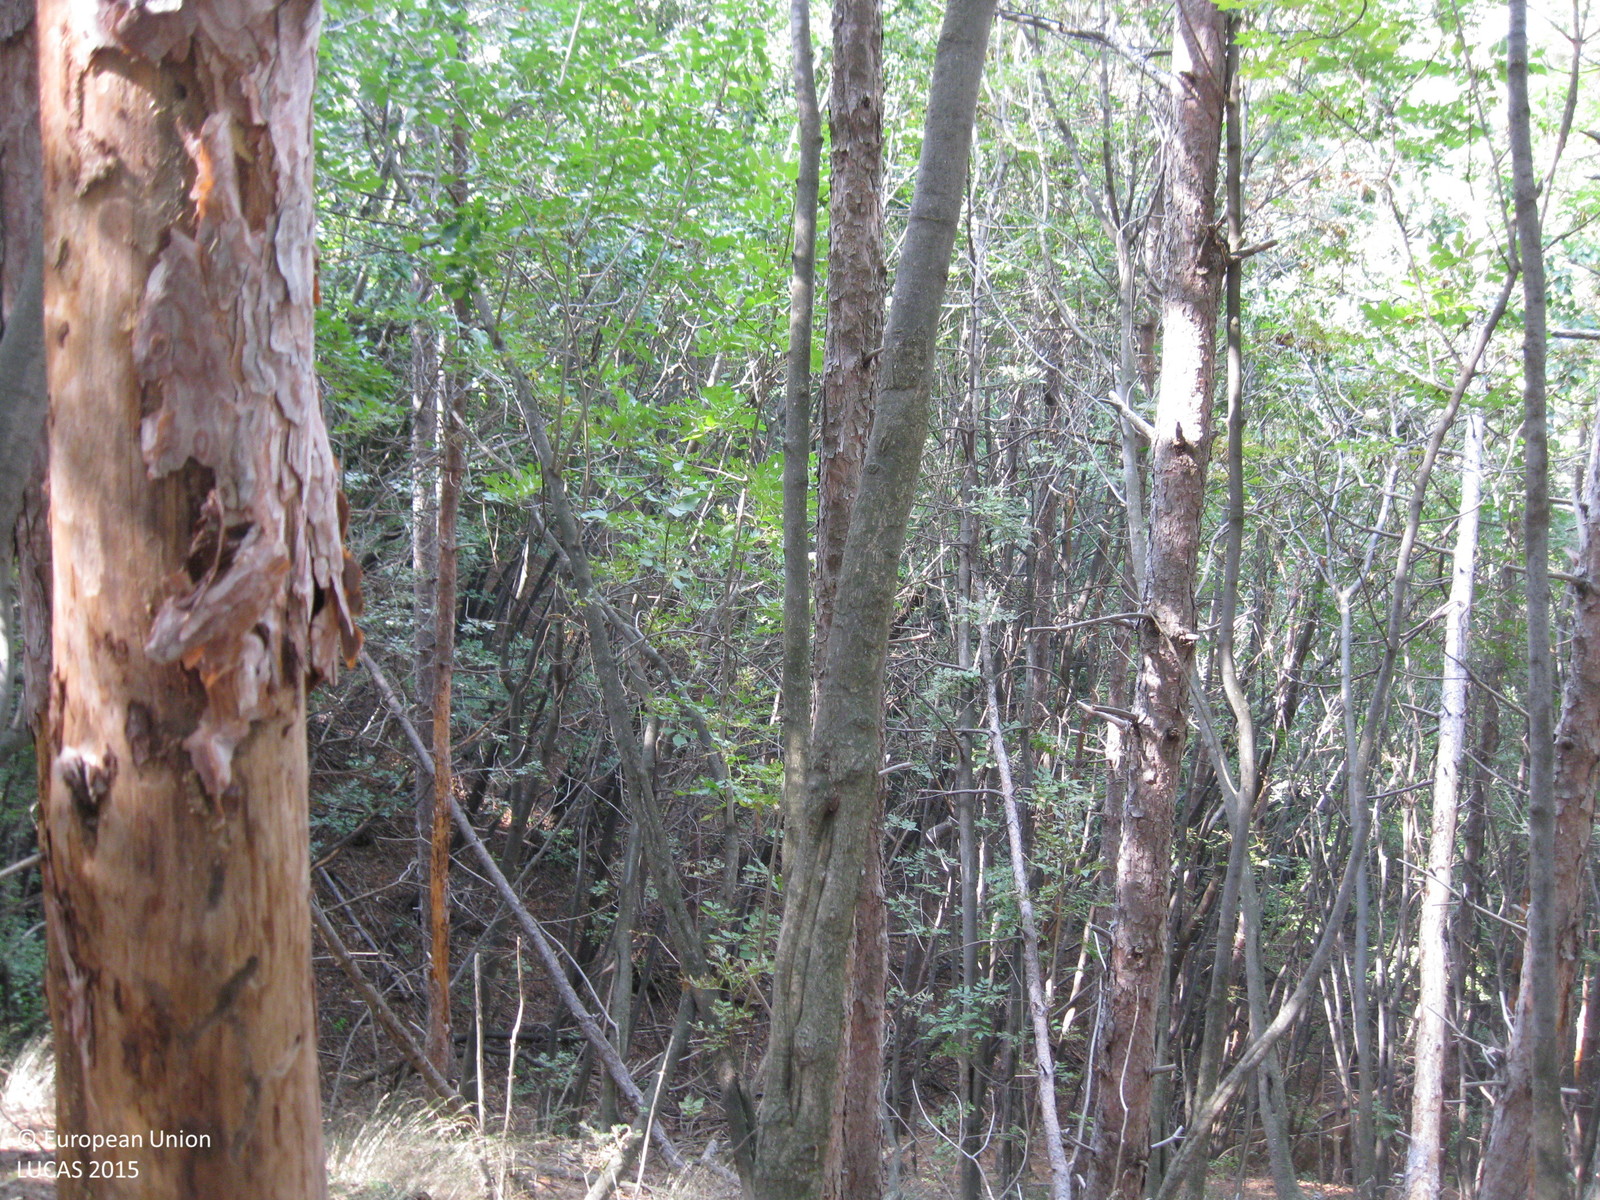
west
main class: Woodland
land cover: Pine dominated mixed woodland
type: alpine coniferous forest
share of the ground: > 75 %
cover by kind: coniferous forest trees 65 %, broadleaved forest trees 35 %
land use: Forestry
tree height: > 5 m
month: October
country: BG
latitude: 42.0434
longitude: 24.7529
